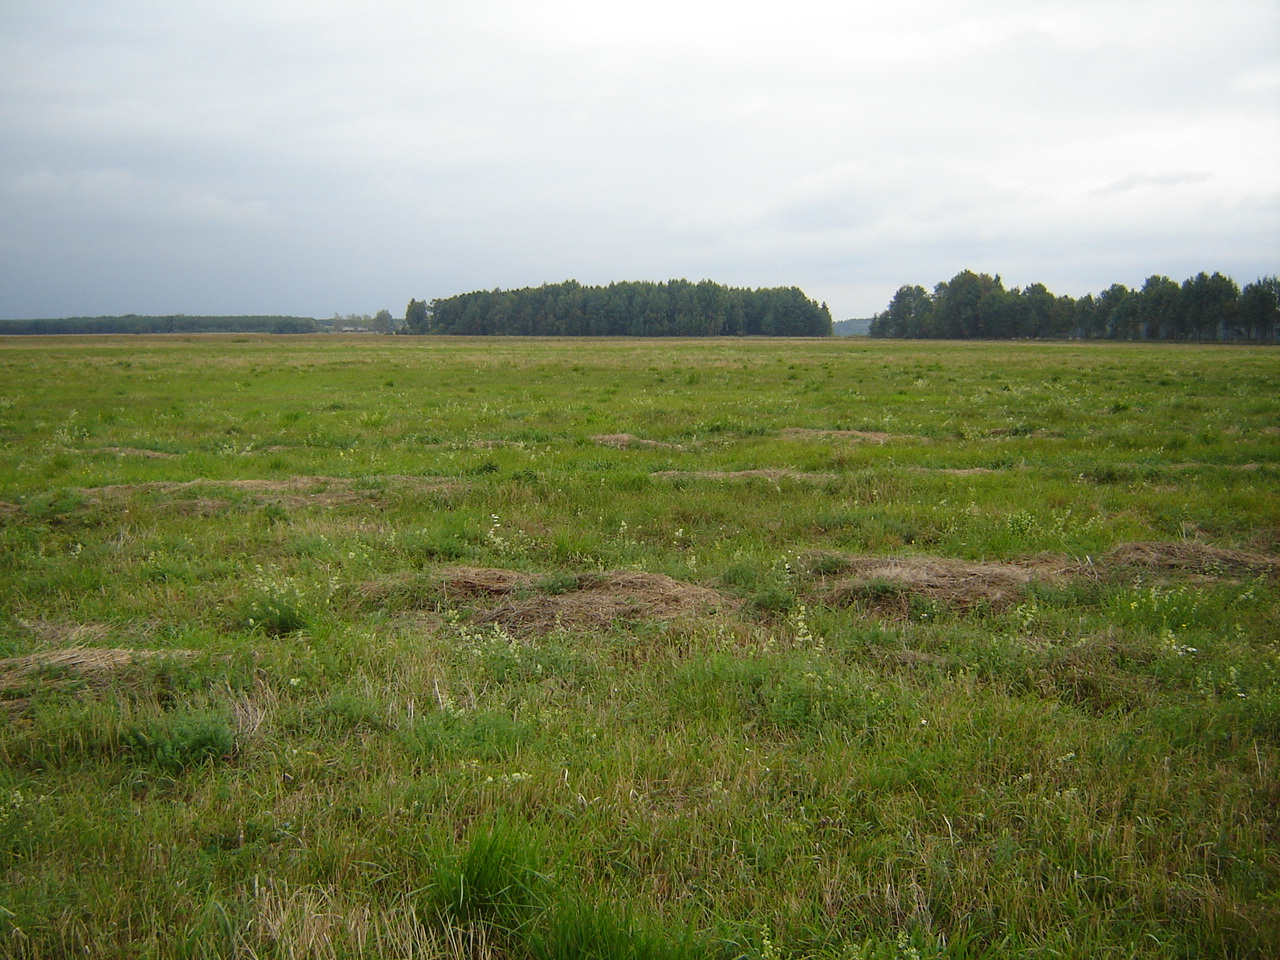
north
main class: Grassland
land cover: Grassland without tree/shrub cover
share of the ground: > 75 %
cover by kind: herbaceous plants 100 %
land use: Agriculture (excluding fallow land and kitchen gardens)
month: September
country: LT
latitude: 54.4006
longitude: 24.8531
